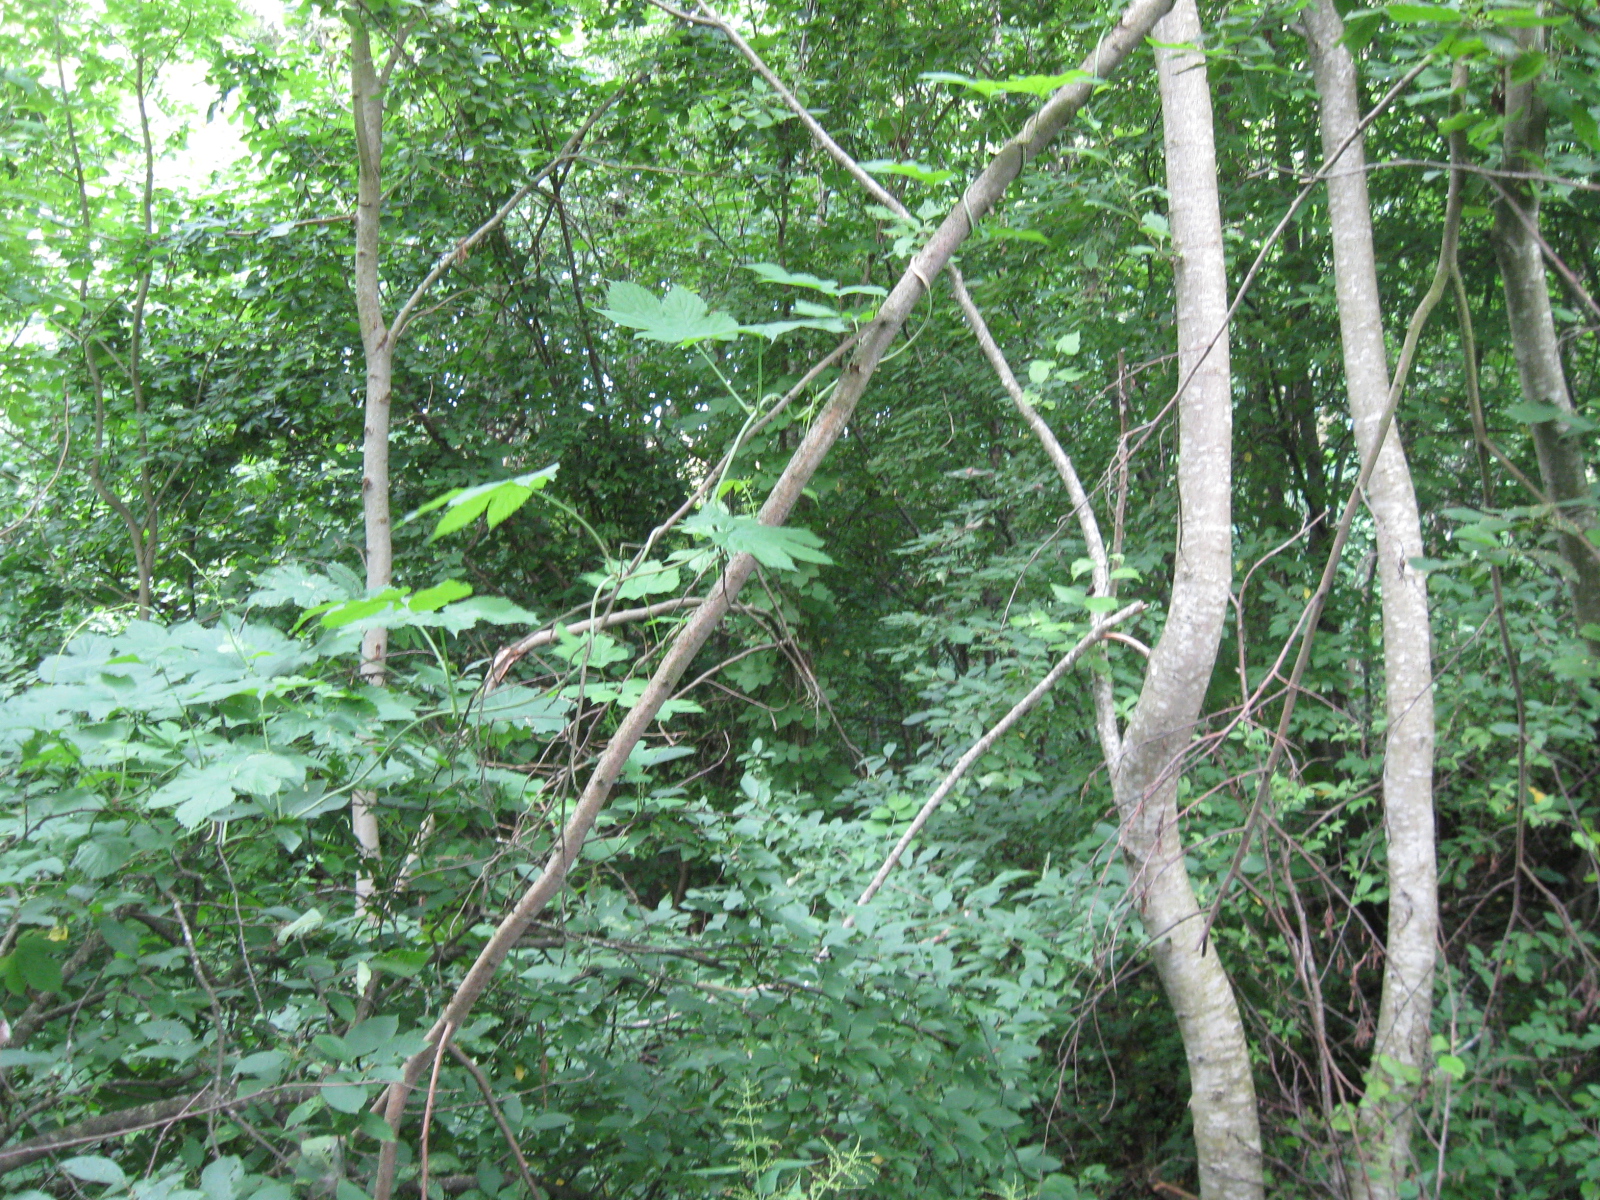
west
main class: Woodland
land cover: Broadleaved woodland
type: floodplain forest
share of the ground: > 75 %
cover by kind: broadleaved forest trees 90 %, herbaceous plants 10 %
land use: Forestry
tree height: > 5 m
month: July
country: LT
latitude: 54.9634
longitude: 23.6246
